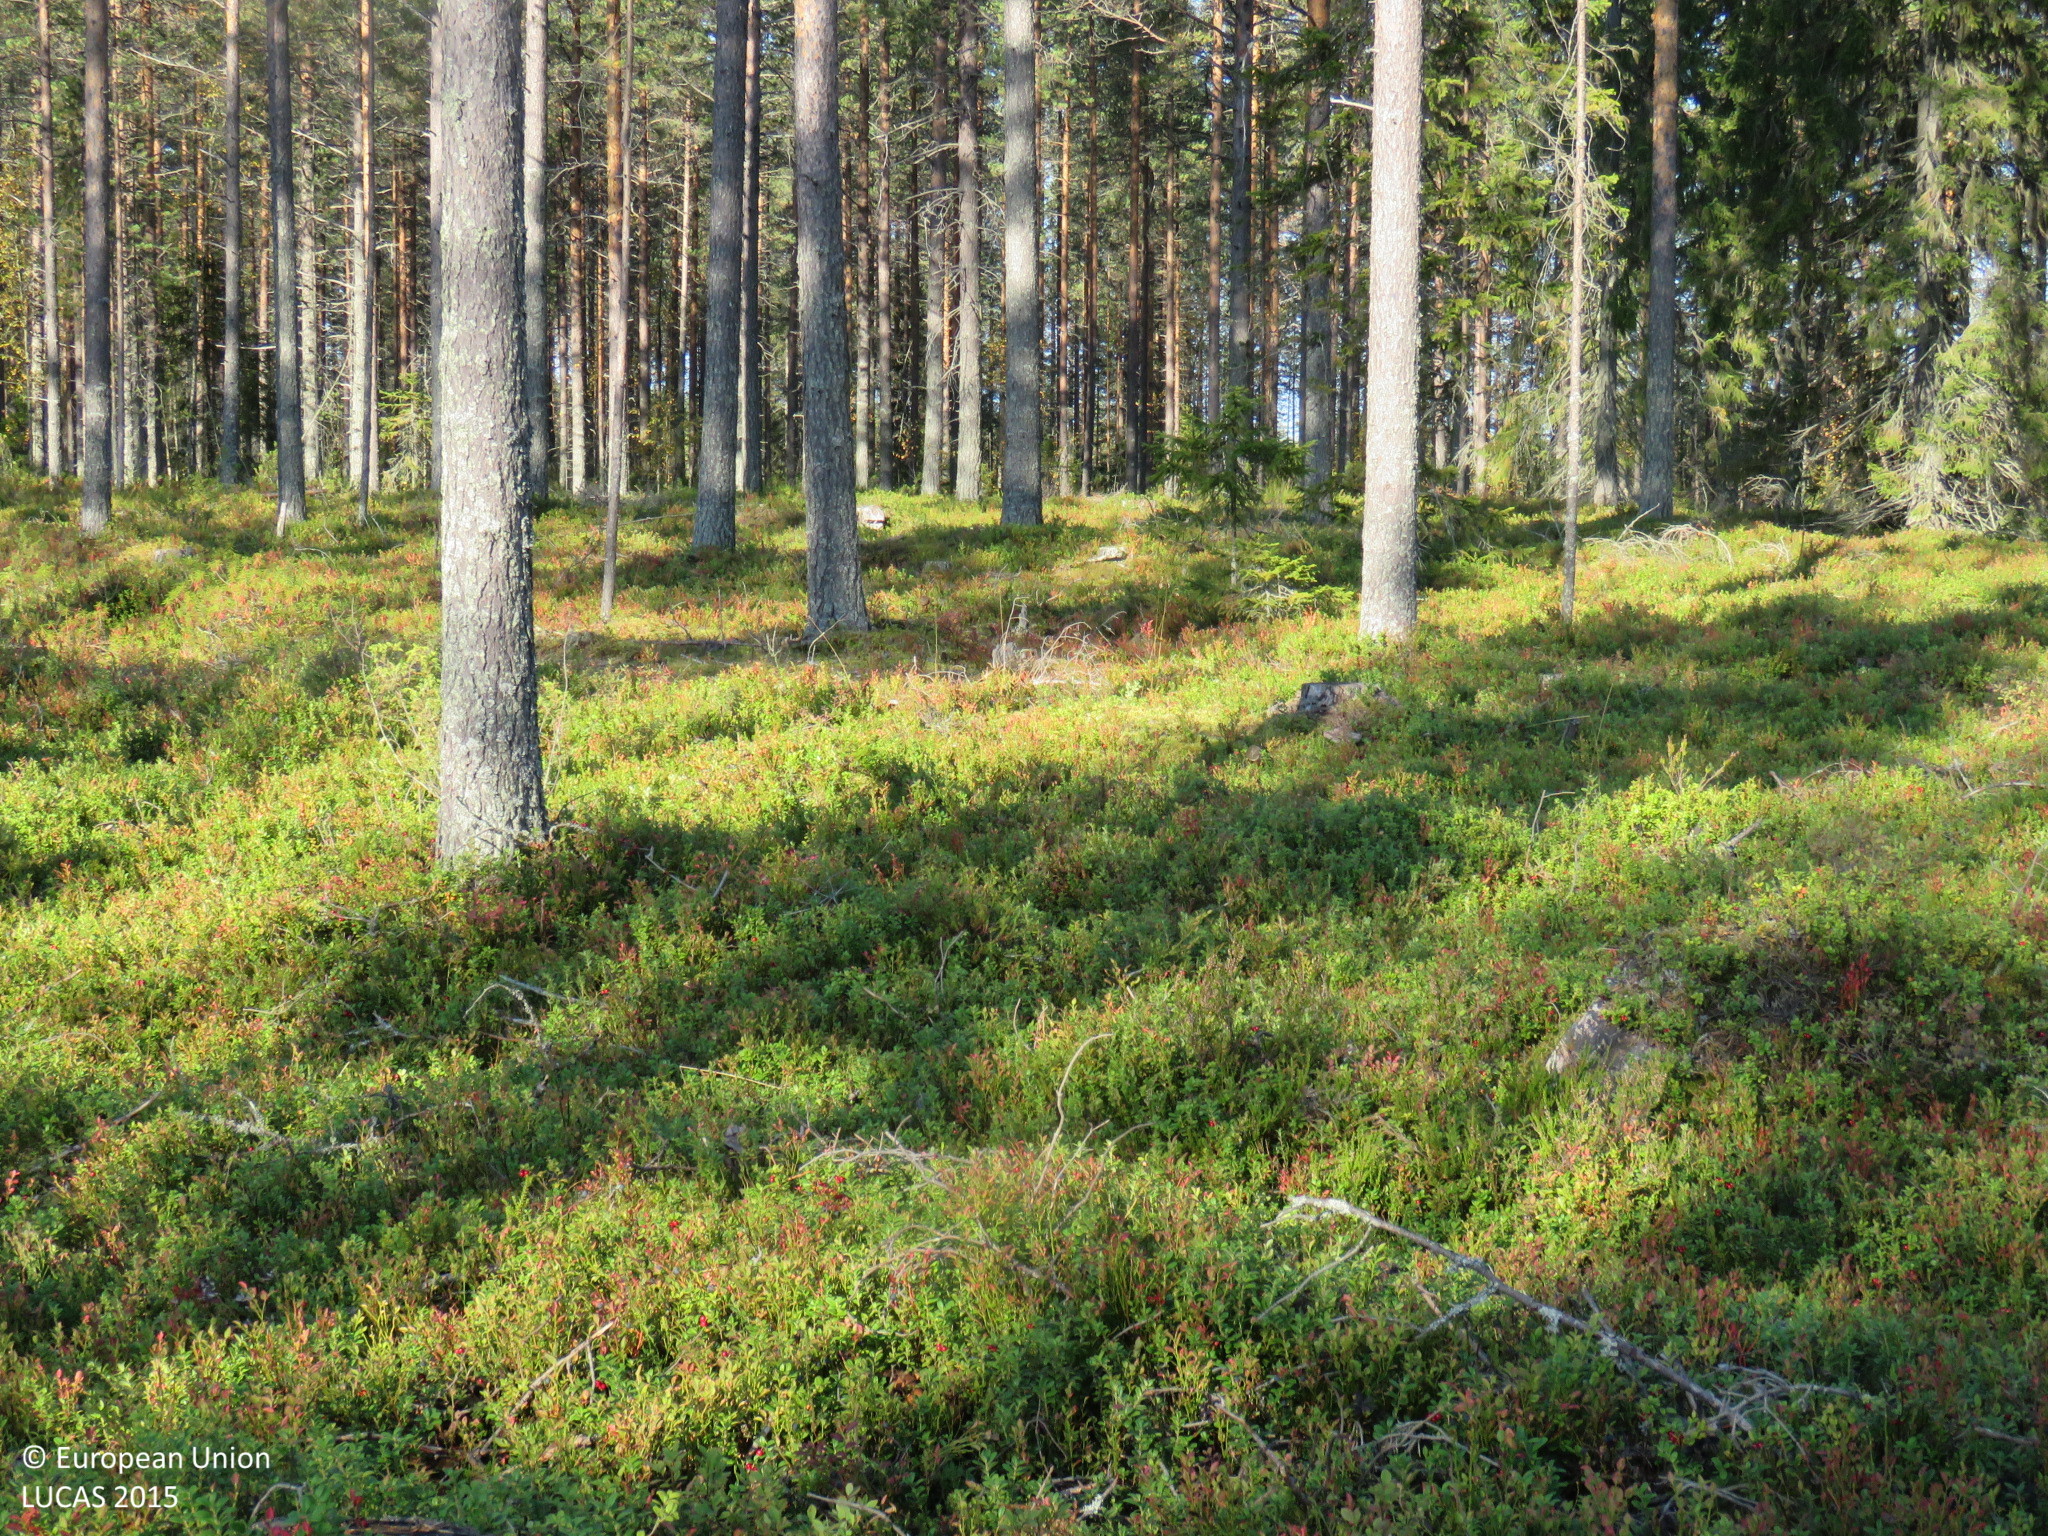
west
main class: Woodland
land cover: Pine dominated coniferous woodland
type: boreal forest
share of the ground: 50 - 75 %
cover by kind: coniferous forest trees 60 %, shrubs 30 %, lichens and mosses 10 %
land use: Forestry
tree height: > 5 m
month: September
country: FI
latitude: 64.9789
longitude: 26.9671
